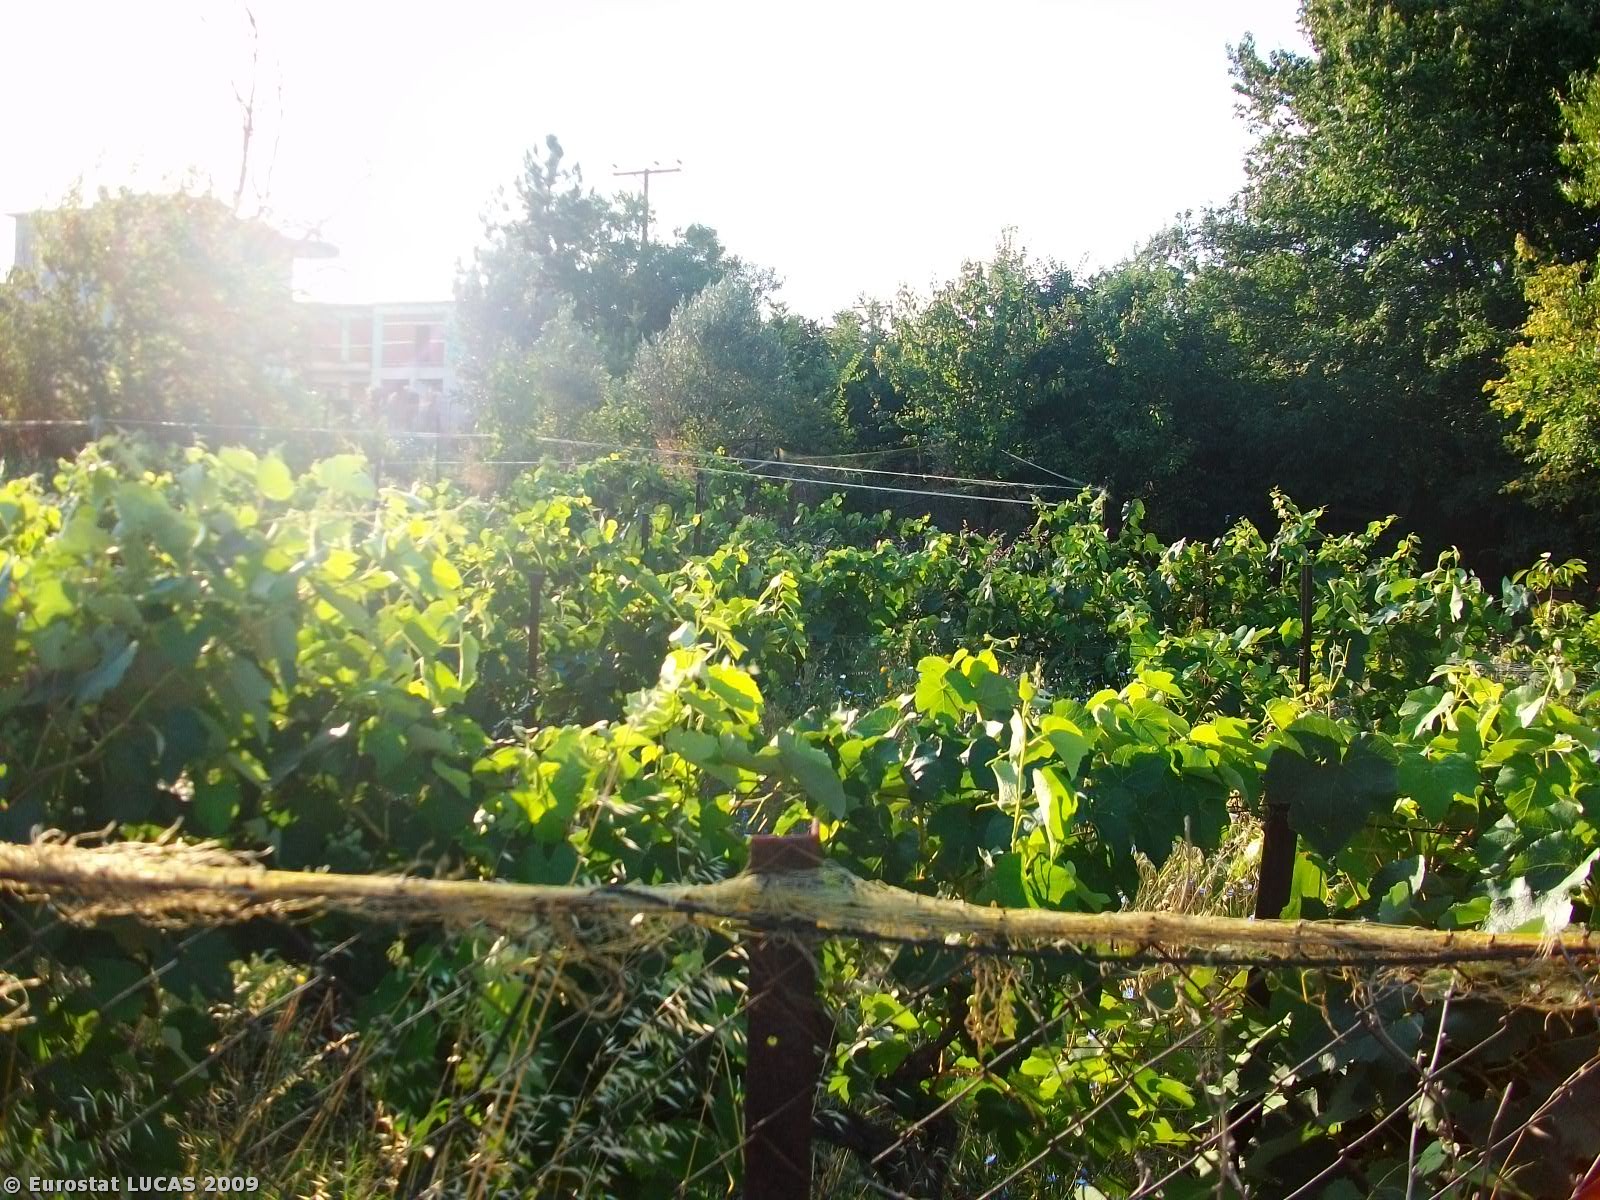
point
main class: Cropland
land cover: Vineyards
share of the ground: 50 - 75 %
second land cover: Grassland with sparse tree/shrub cover
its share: > 75 %
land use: Agriculture (excluding fallow land and kitchen gardens)
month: July
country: GR
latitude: 41.0139
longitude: 22.8166
